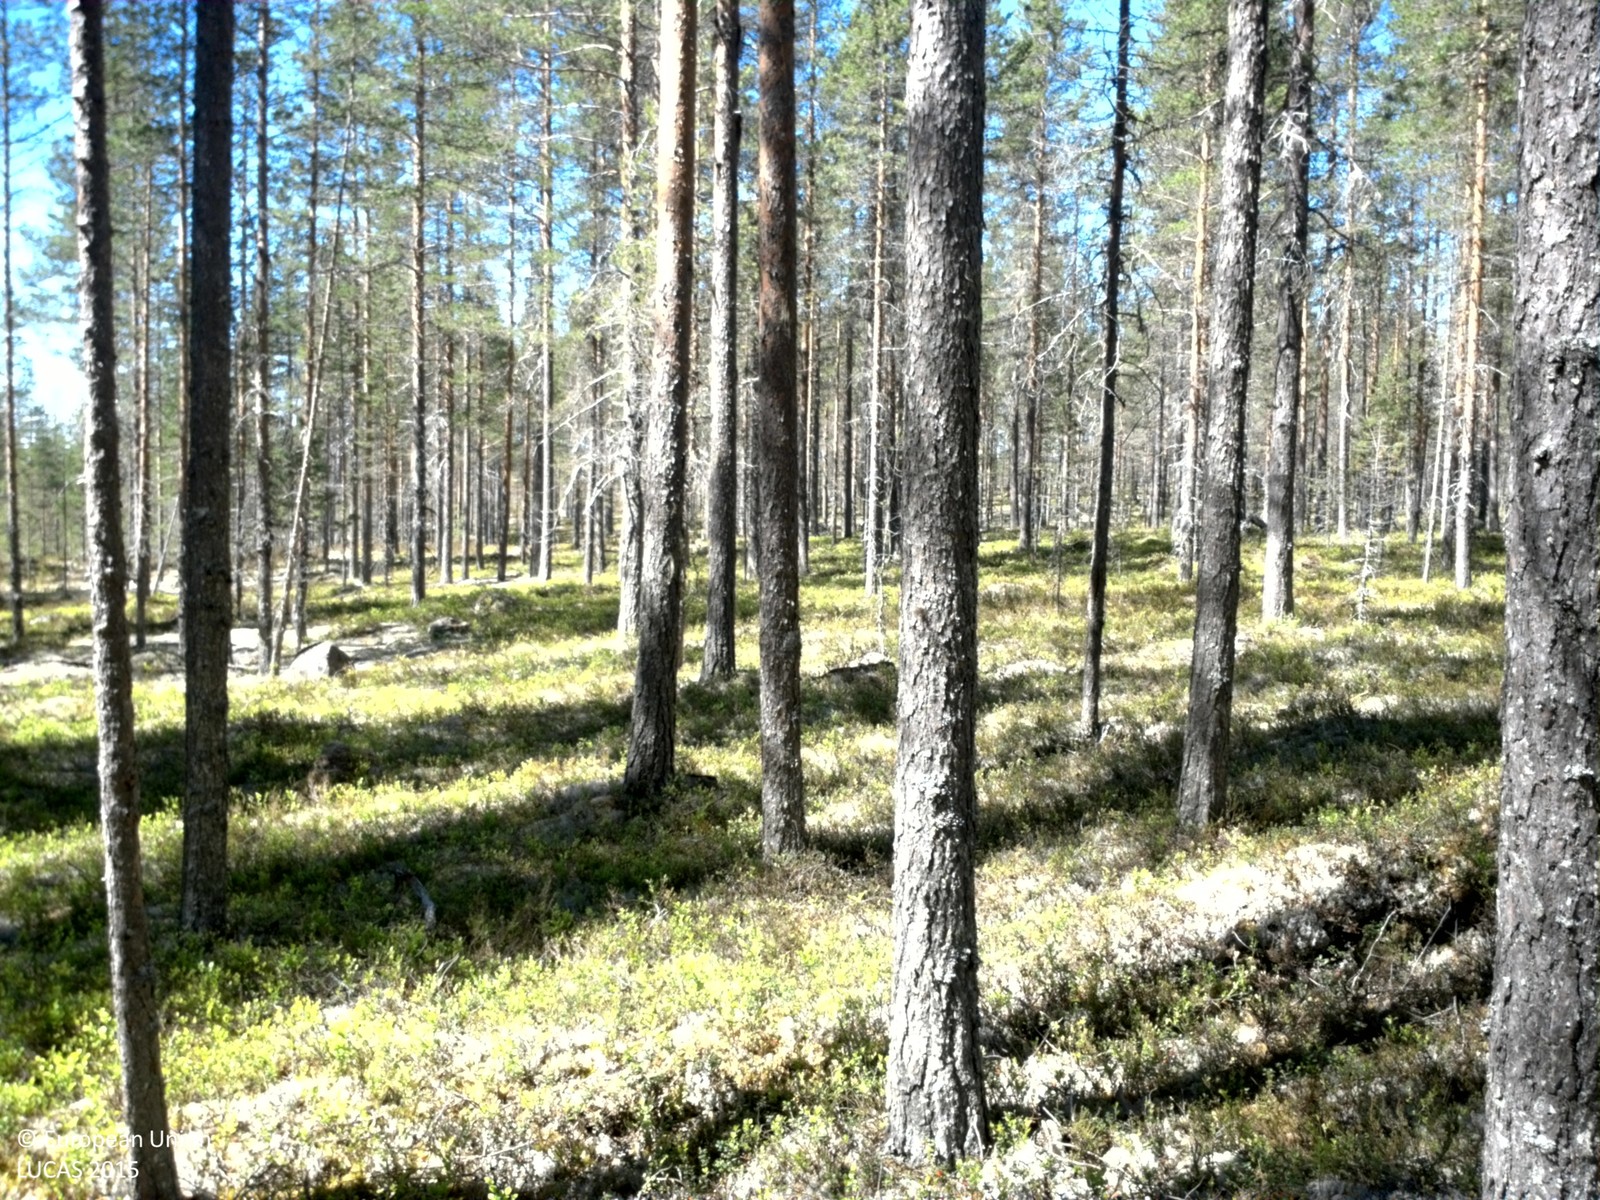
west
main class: Woodland
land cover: Pine dominated coniferous woodland
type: boreal forest
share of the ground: > 75 %
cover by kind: coniferous forest trees 75 %, herbaceous plants 15 %, lichens and mosses 10 %
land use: Forestry
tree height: > 5 m
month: June
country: SE
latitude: 61.3957
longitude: 13.6384
